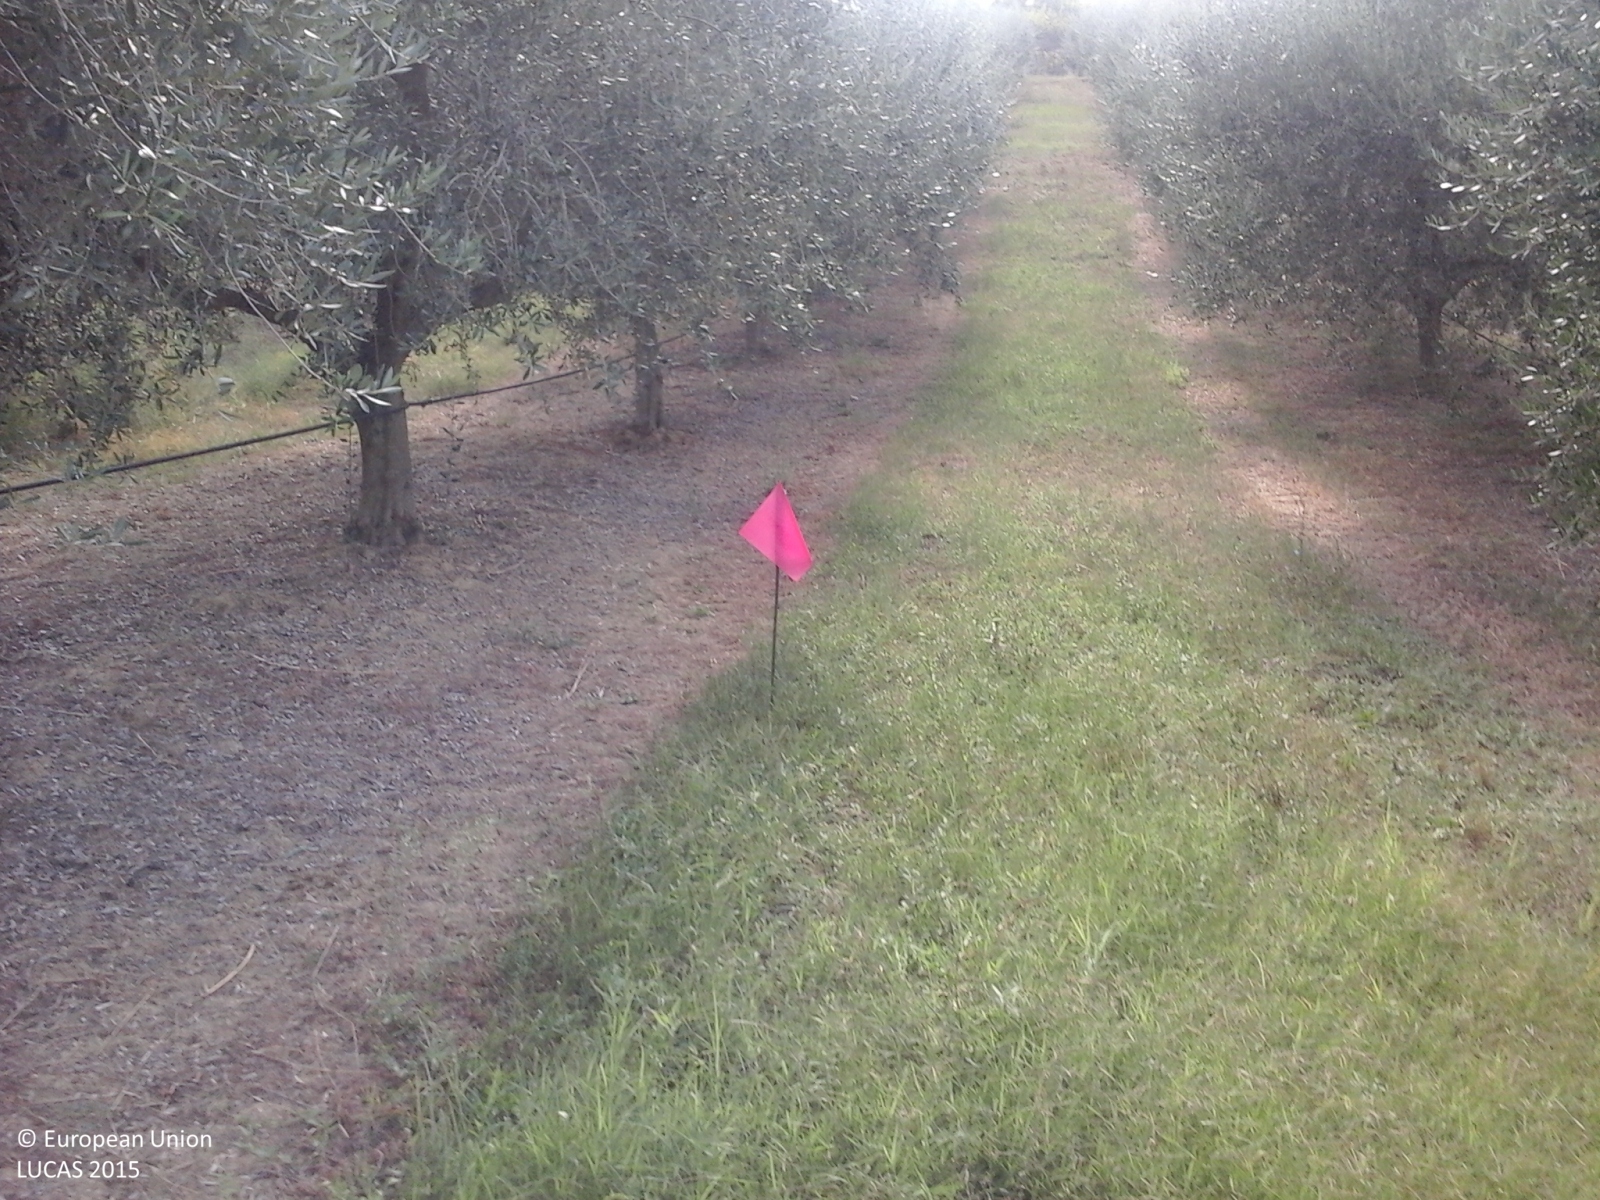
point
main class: Cropland
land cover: Olive groves
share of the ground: 50 - 75 %
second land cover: Grassland without tree/shrub cover
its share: > 75 %
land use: Agriculture (excluding fallow land and kitchen gardens)
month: September
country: IT
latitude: 43.8056
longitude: 12.8646
